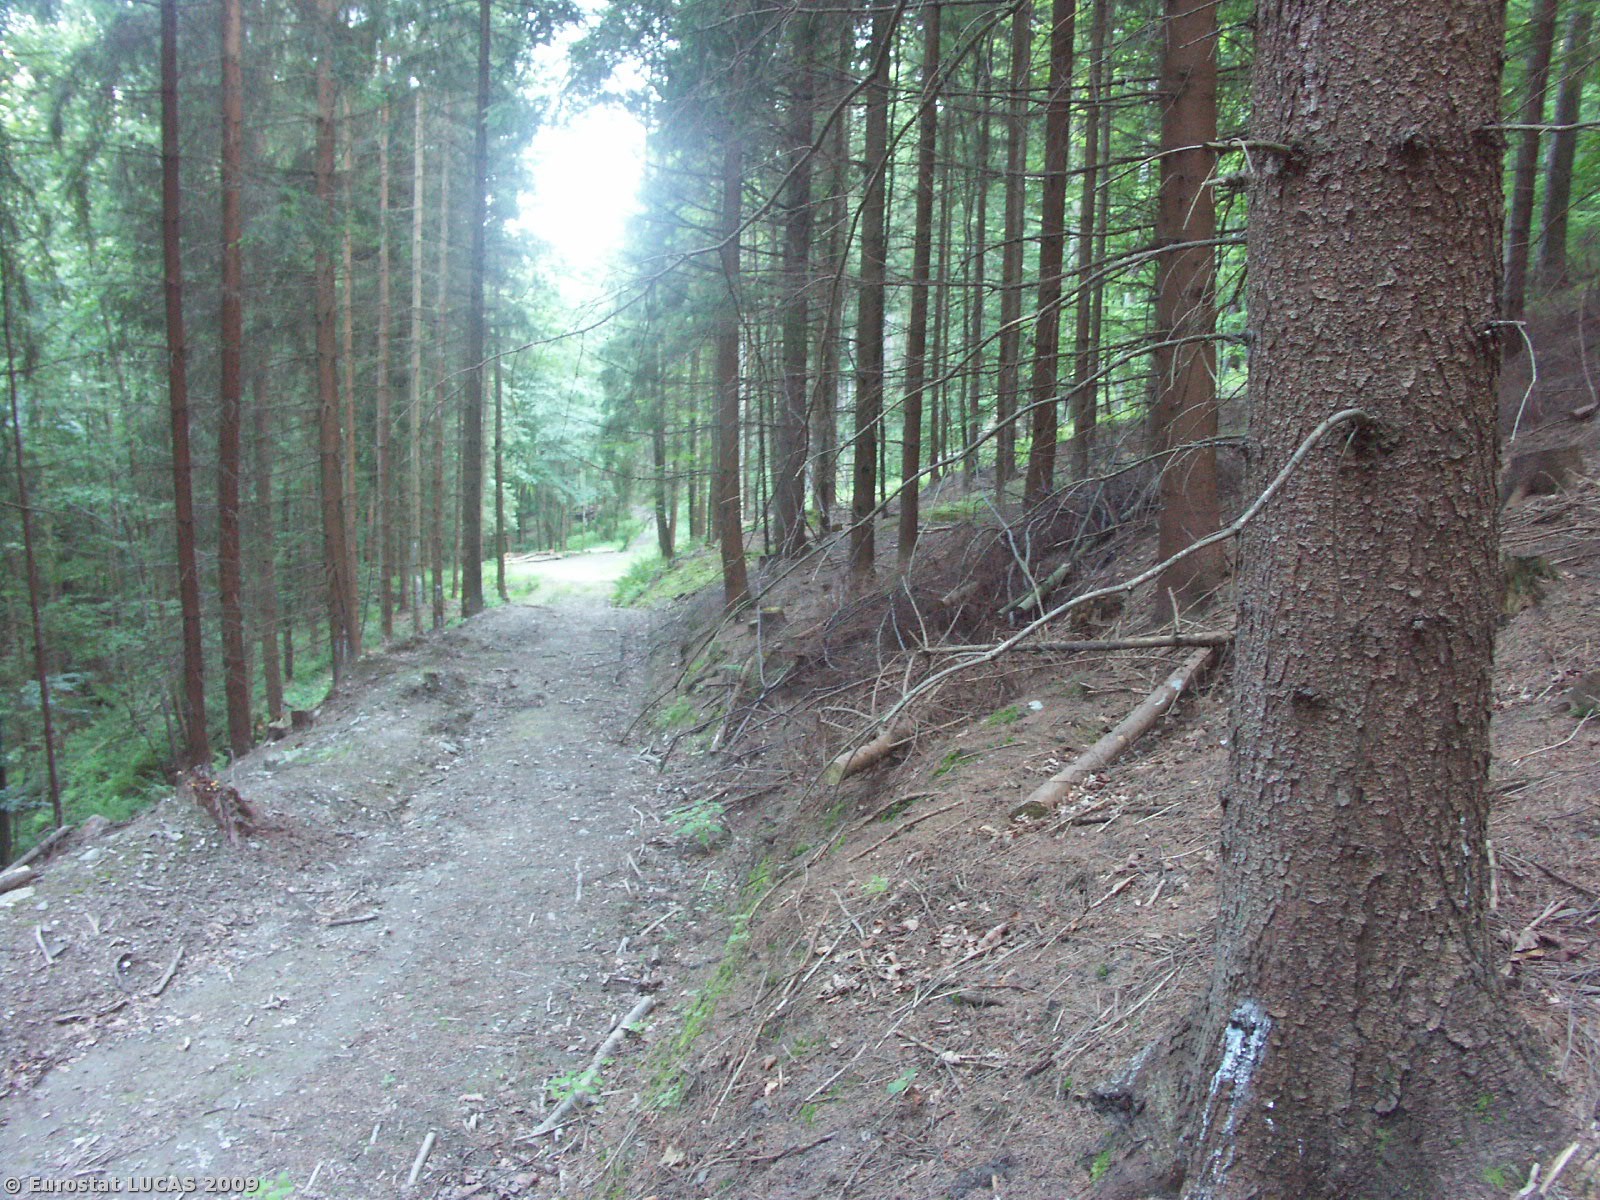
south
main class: Woodland
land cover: Coniferous woodland
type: hemiboreal forest and nemoral coniferous forest and mixed broadleaved-coniferous forest
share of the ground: > 75 %
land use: Forestry
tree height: > 5 m
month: July
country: CZ
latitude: 49.8821
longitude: 17.2338
